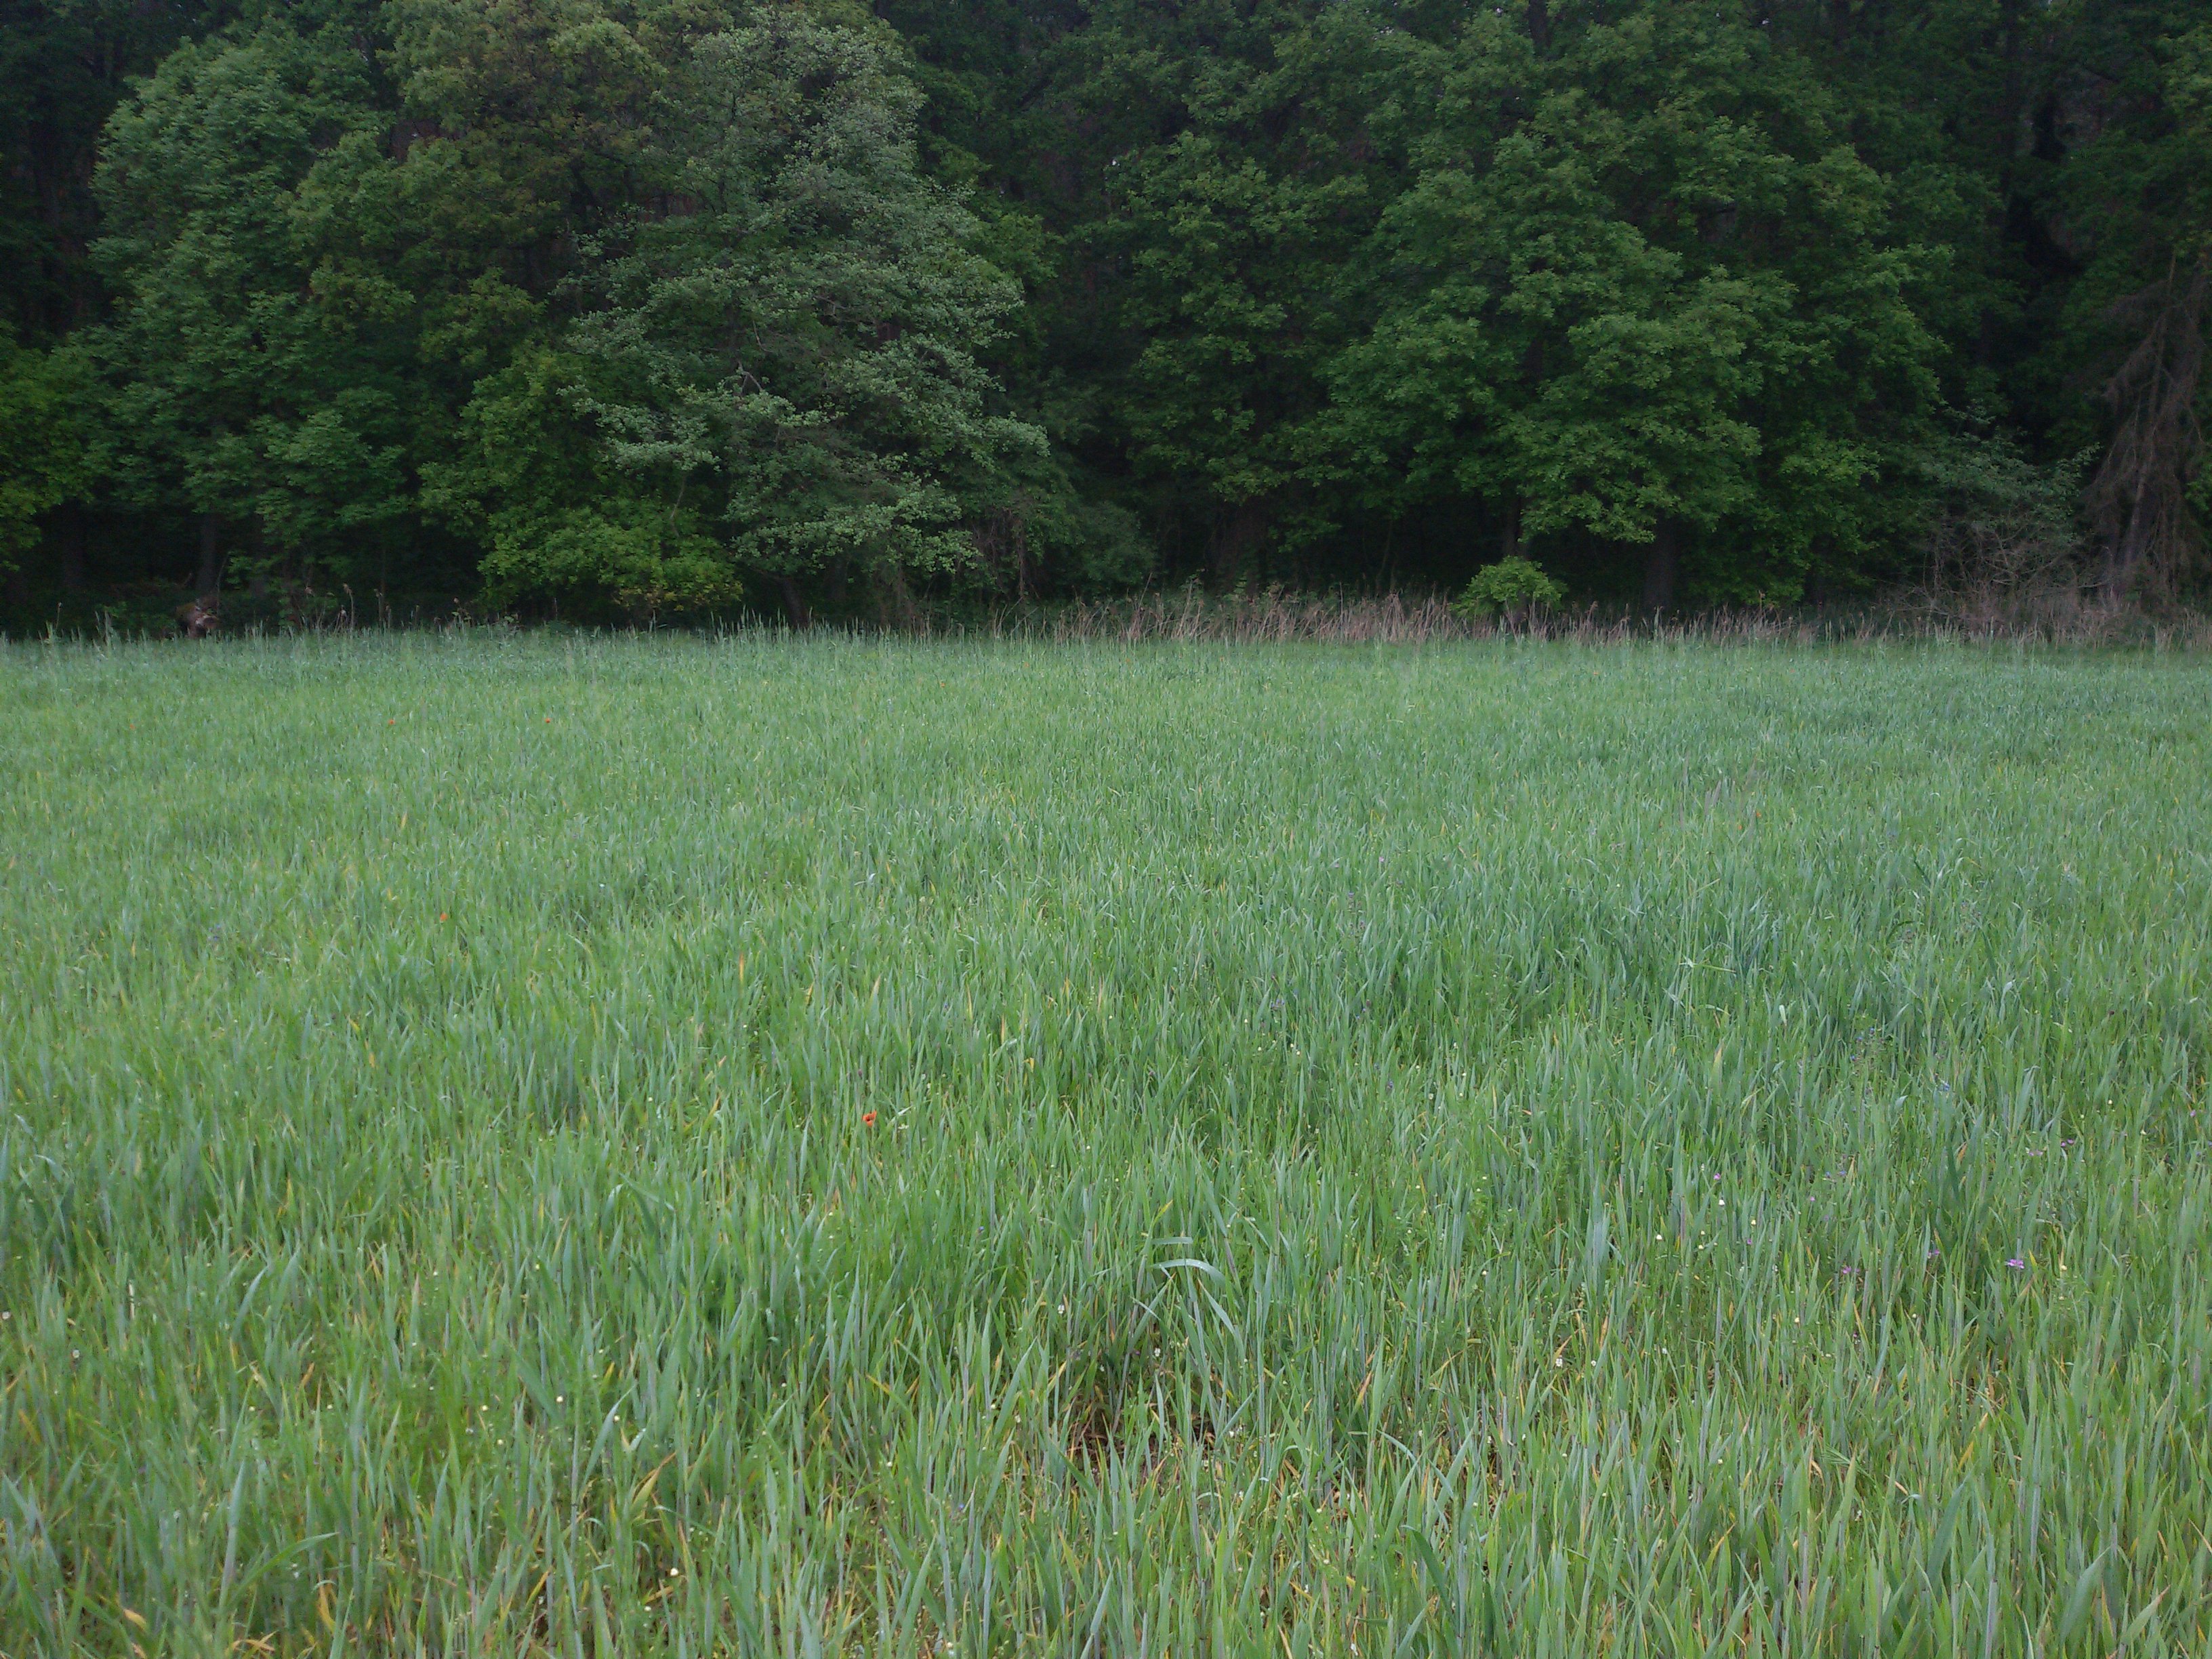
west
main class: Cropland
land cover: Triticale
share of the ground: > 75 %
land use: Agriculture (excluding fallow land and kitchen gardens)
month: May
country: PL
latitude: 52.2322
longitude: 16.8763
